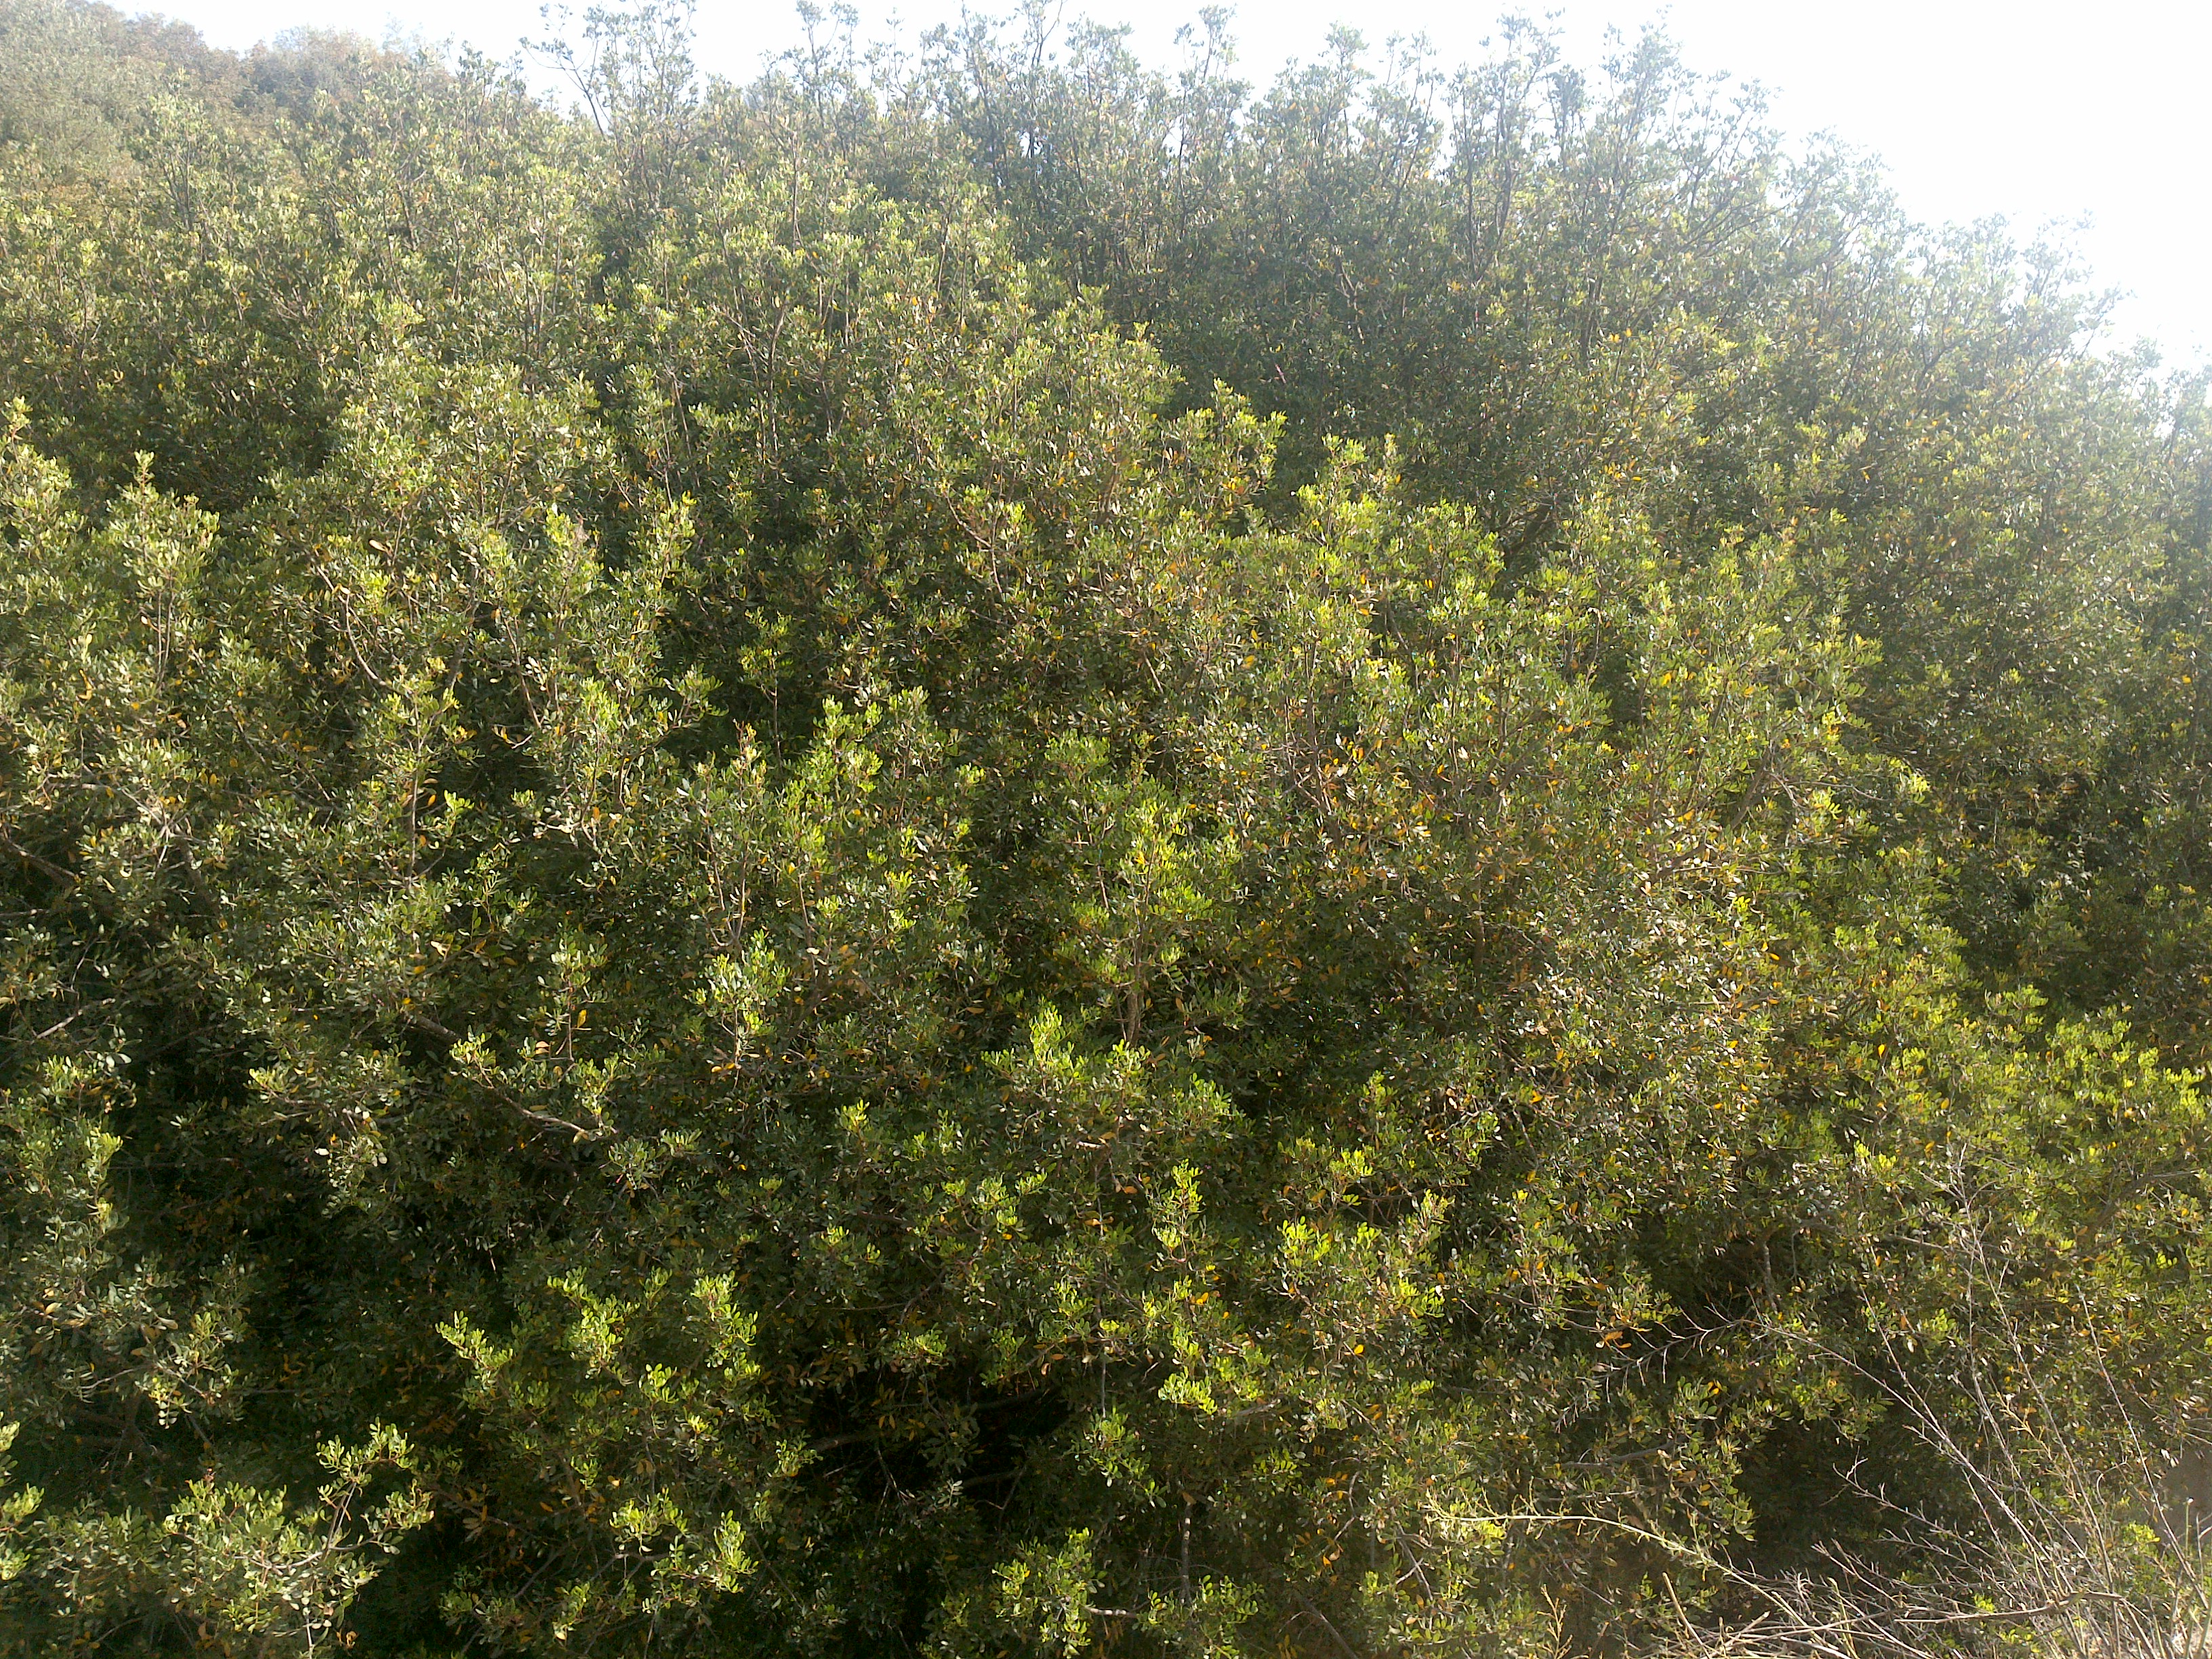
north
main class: Shrubland
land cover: Shrubland without tree cover
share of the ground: 50 - 75 %
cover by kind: shrubs 60 %, herbaceous plants 20 %, unconsolidated bare surface 20 %
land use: Semi-natural and natural areas not in use
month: July
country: ES
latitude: 37.3602
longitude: -4.5332
